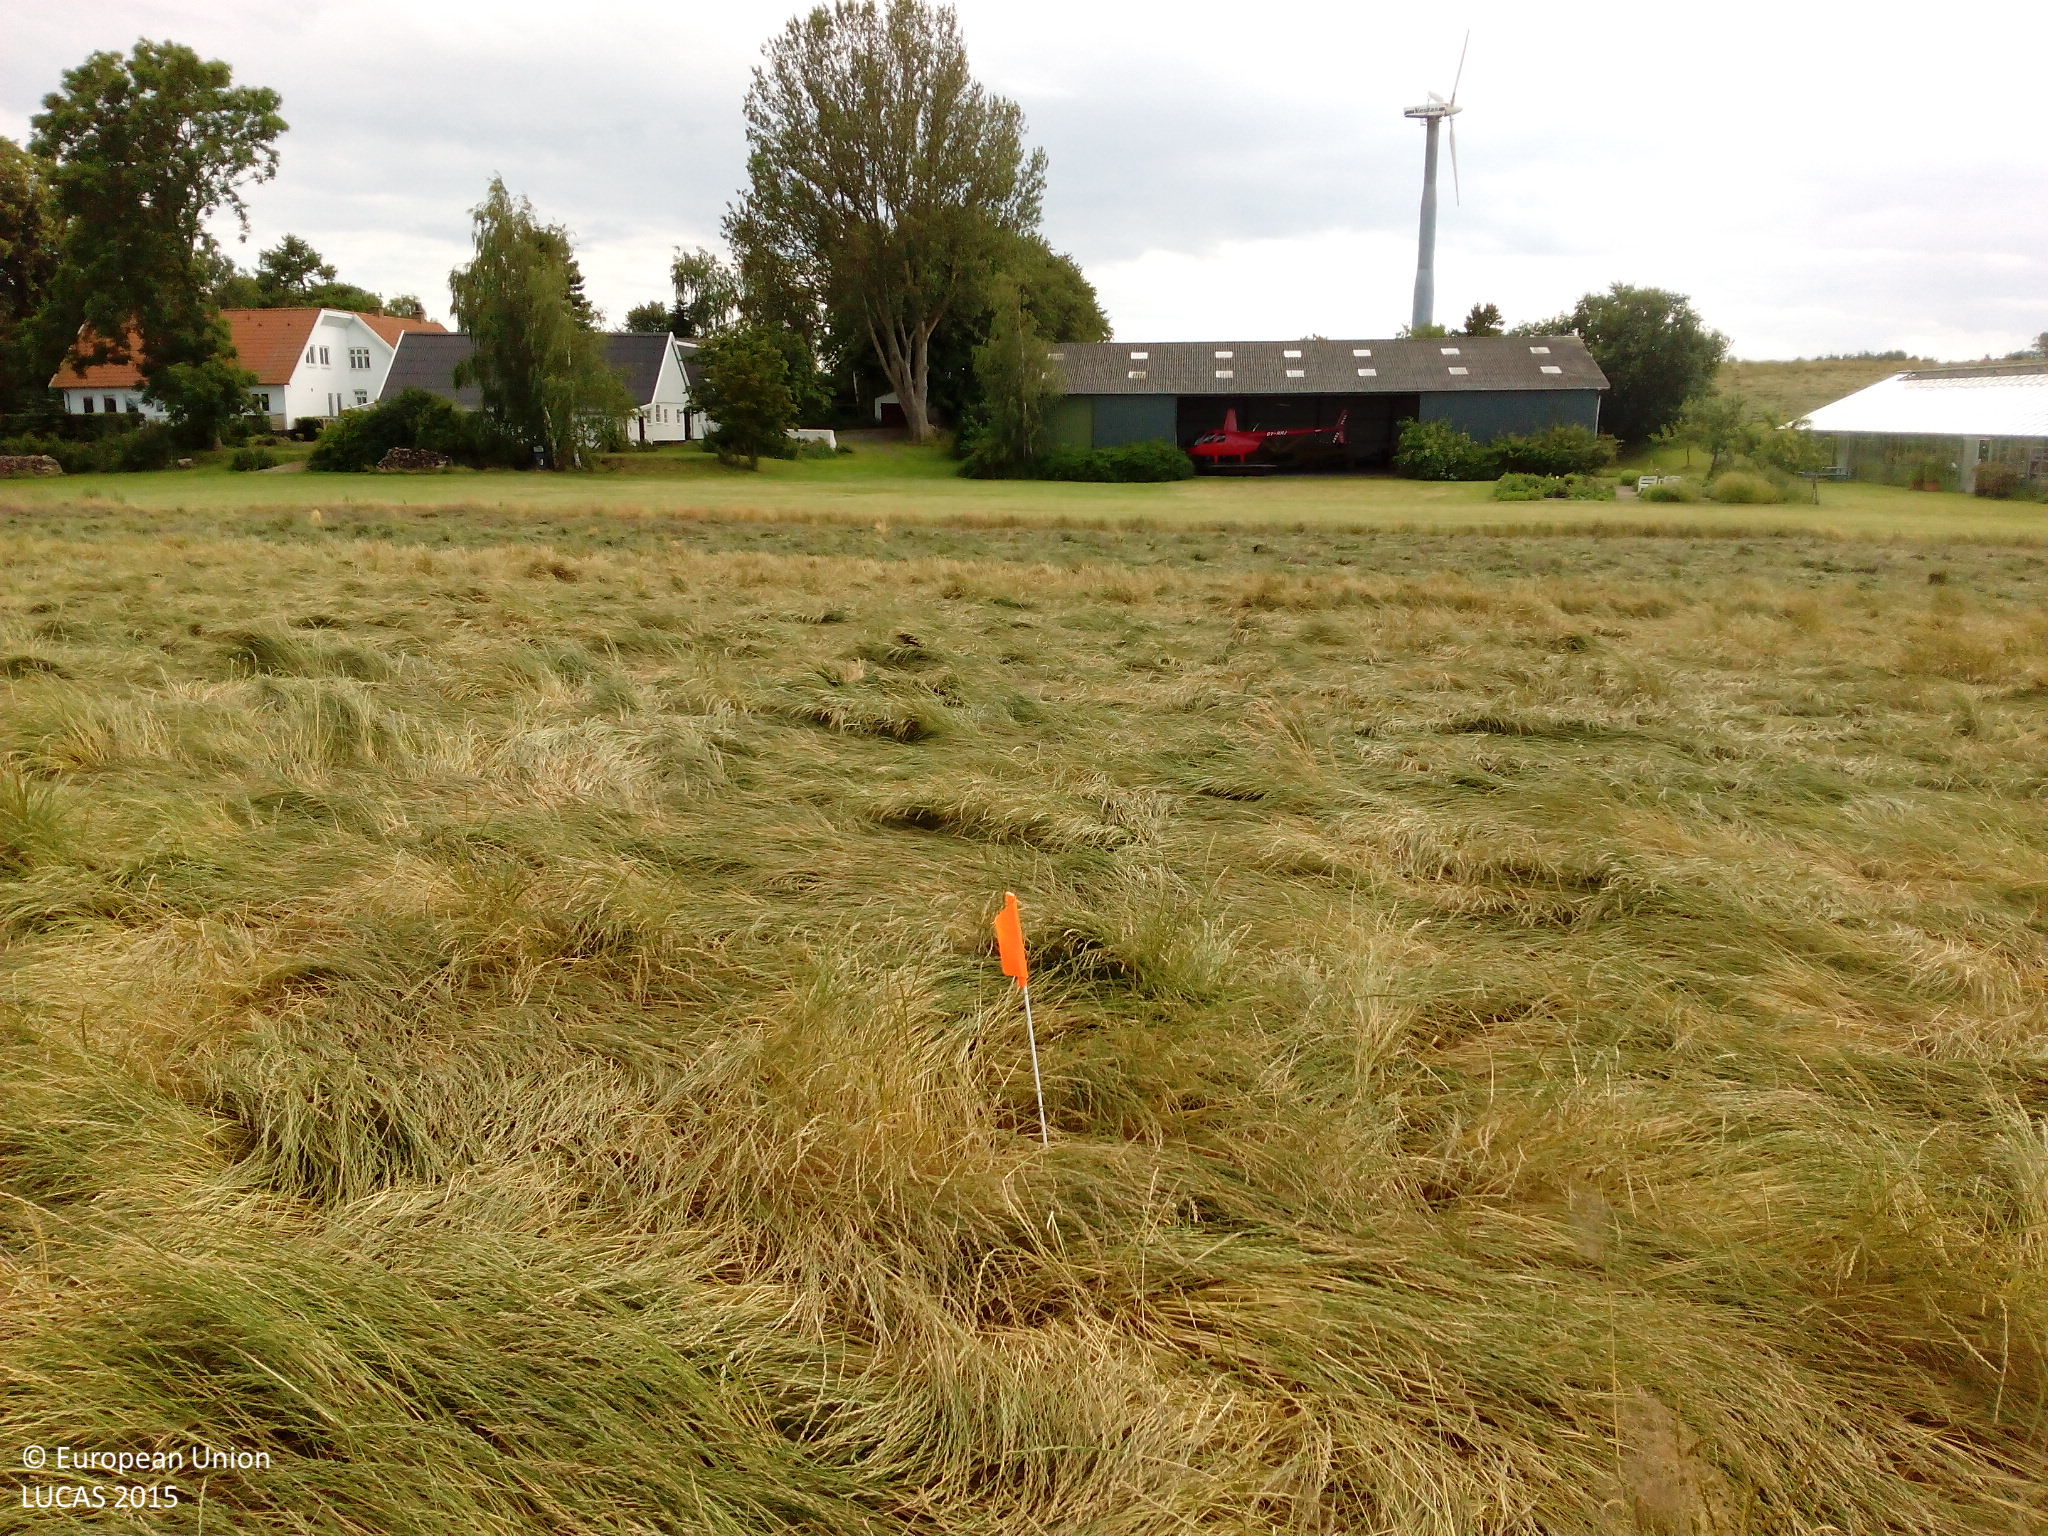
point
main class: Cropland
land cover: Temporary grasslands
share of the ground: > 75 %
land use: Agriculture (excluding fallow land and kitchen gardens)
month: July
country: DK
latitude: 55.3368
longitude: 11.2444
